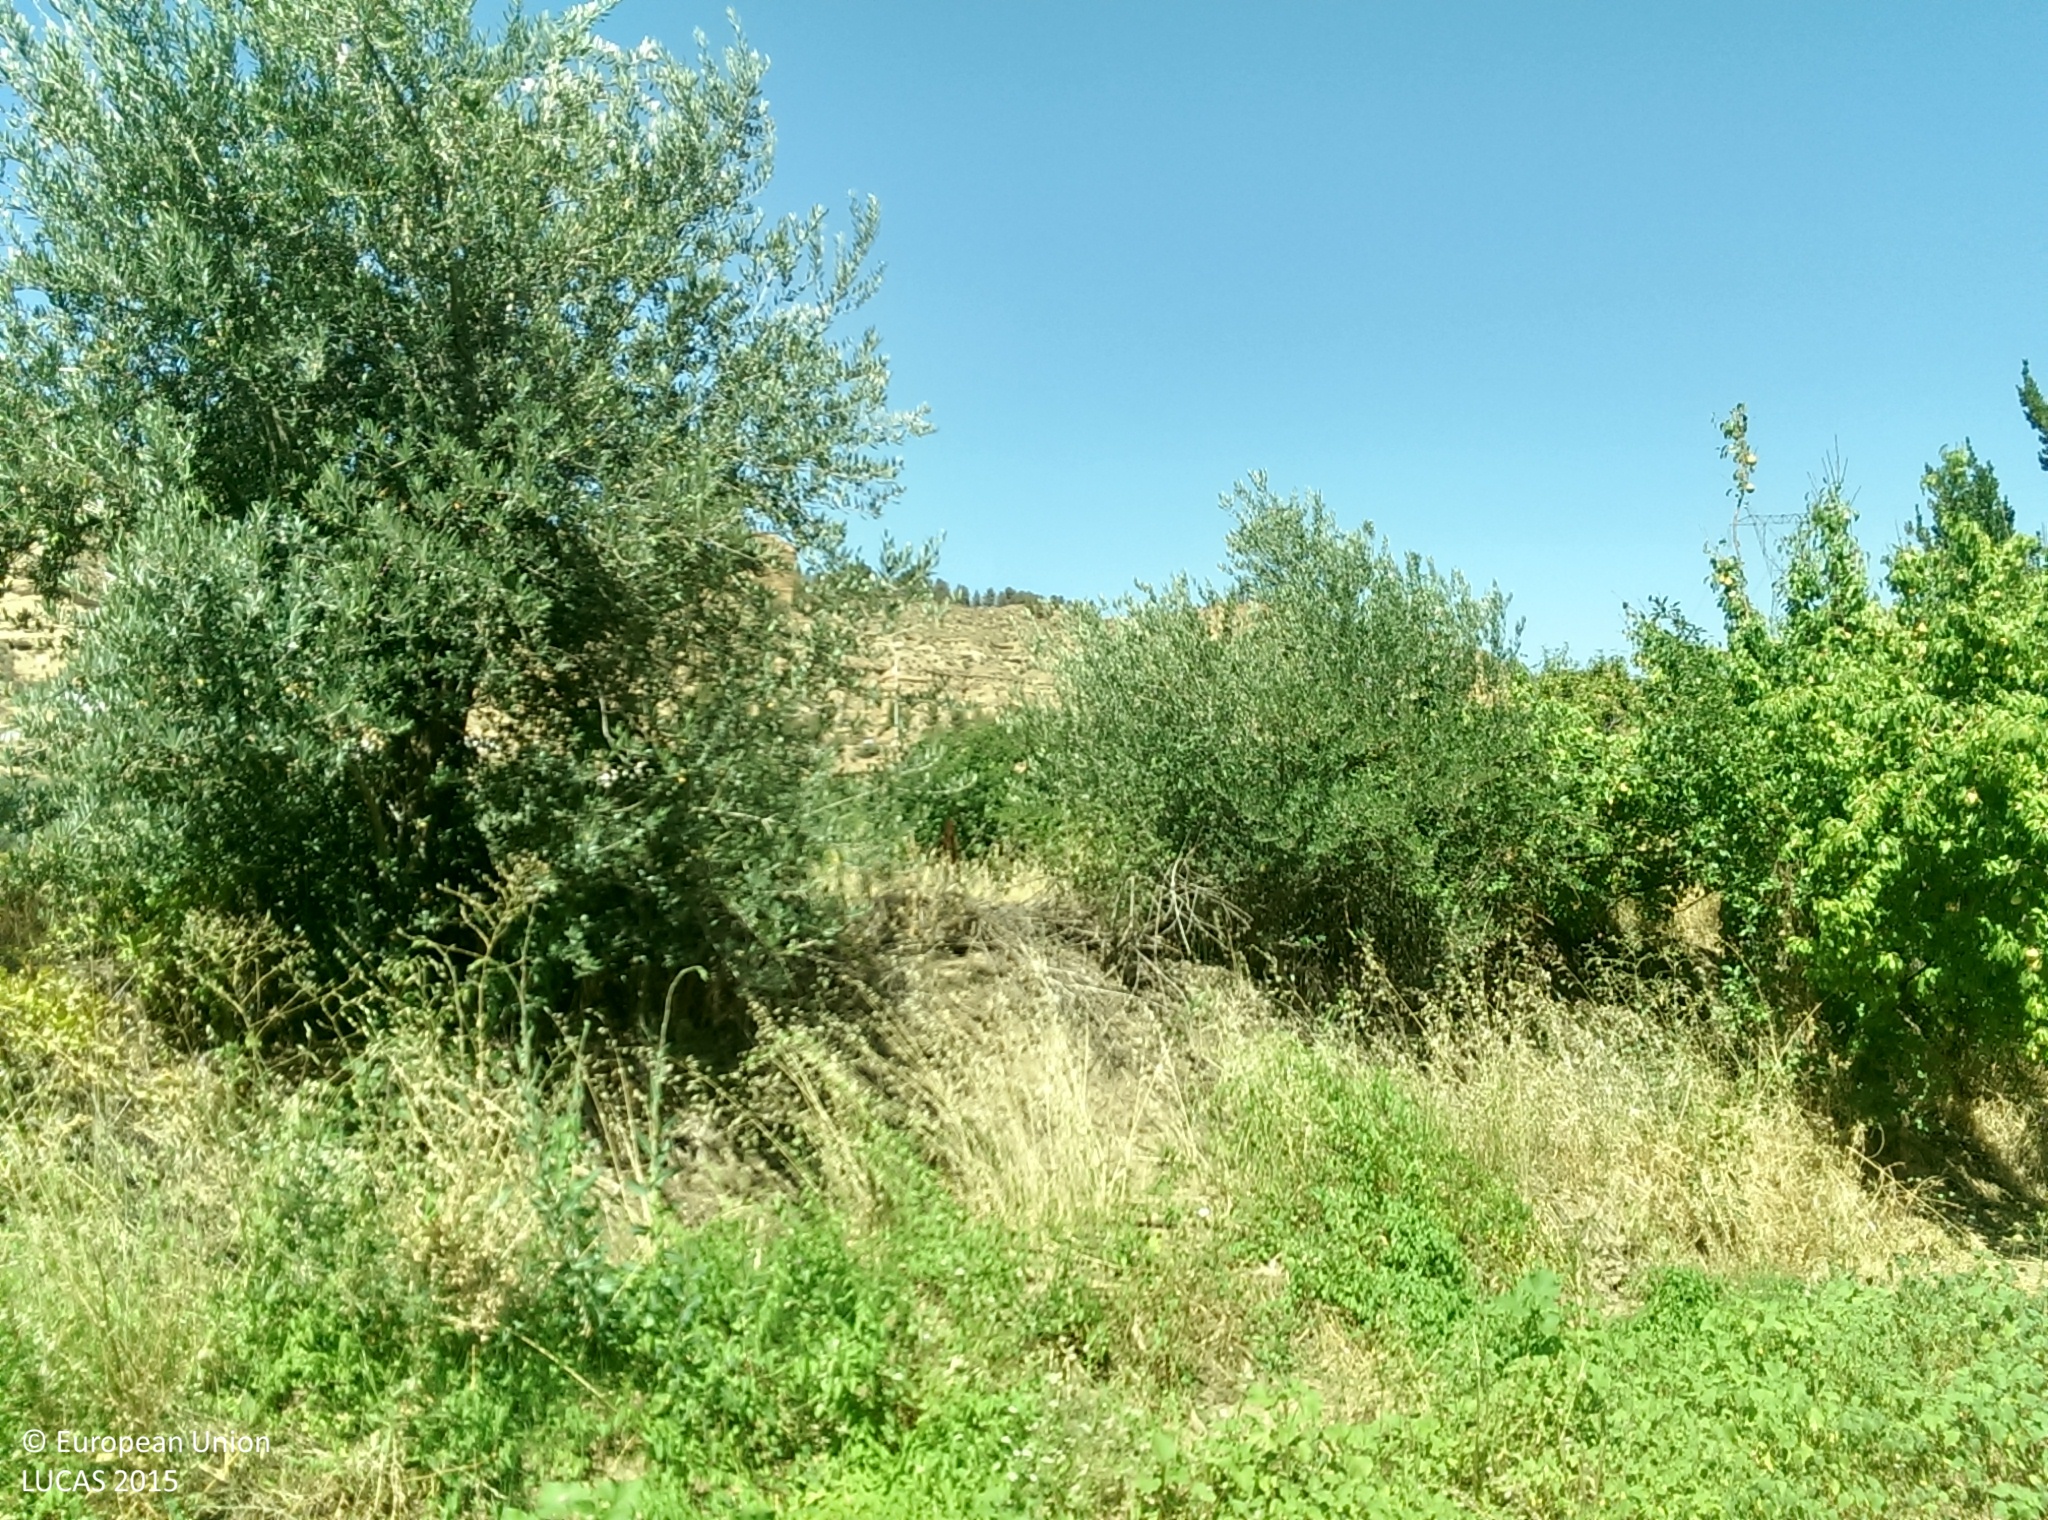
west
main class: Grassland
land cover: Spontaneously vegetated surfaces
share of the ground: 50 - 75 %
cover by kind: herbaceous plants 60 %, unconsolidated bare surface 40 %
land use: Fallow land
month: July
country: ES
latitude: 37.3004
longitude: -3.1983
